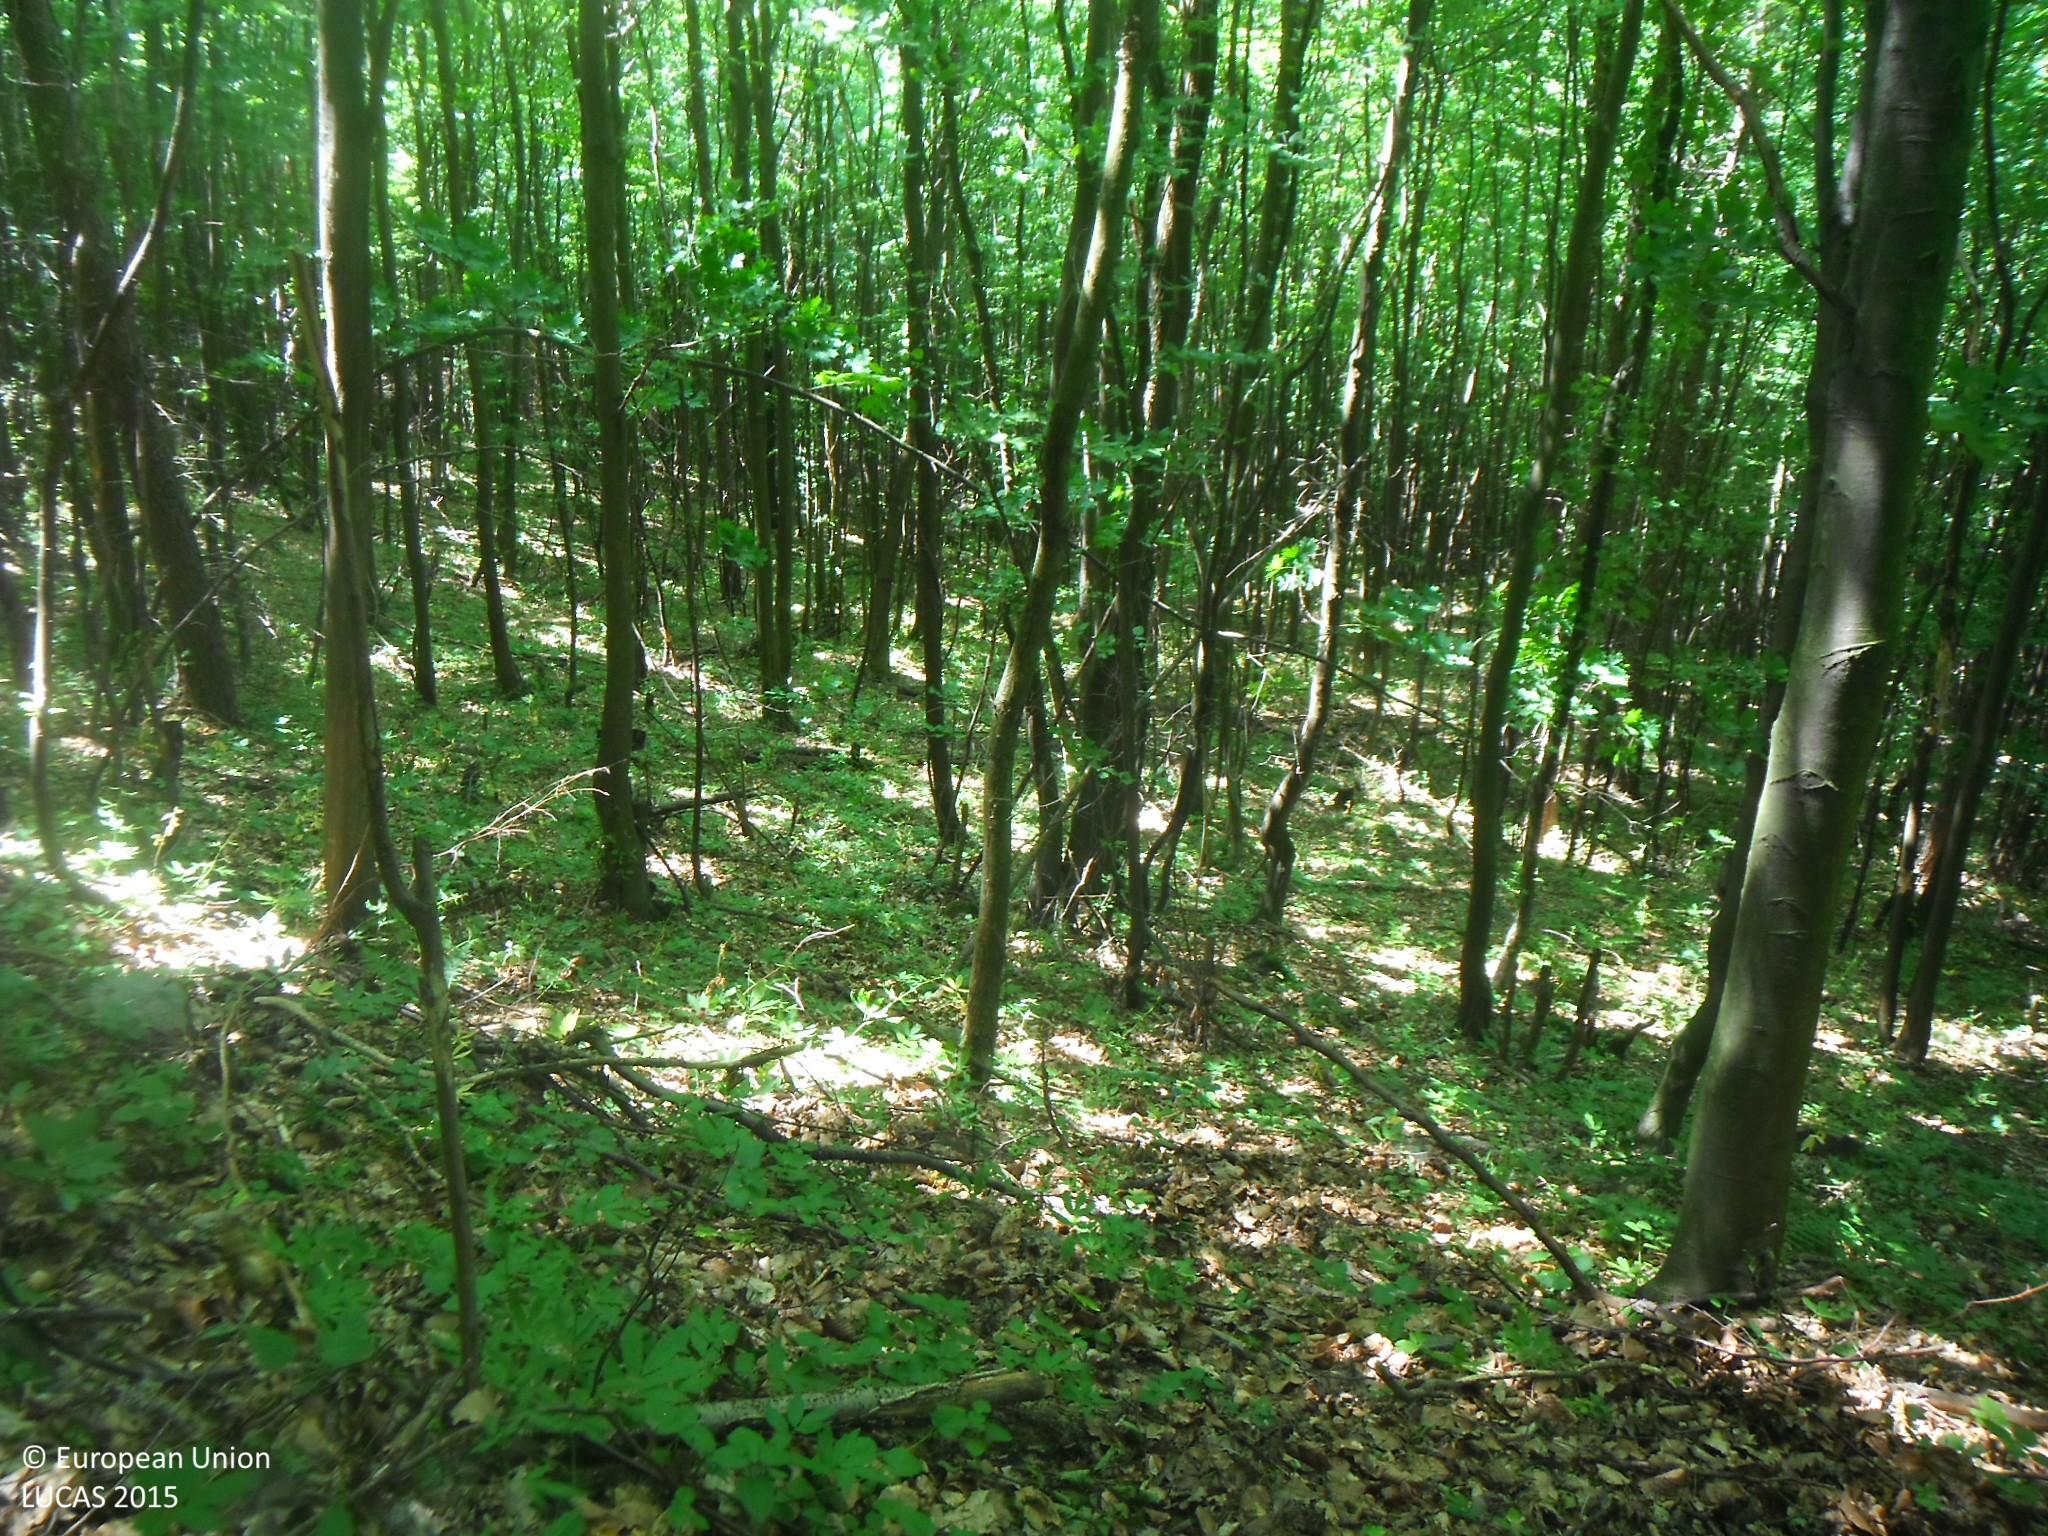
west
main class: Woodland
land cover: Broadleaved woodland
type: beech forest
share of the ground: > 75 %
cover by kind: broadleaved forest trees 100 %
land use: Forestry
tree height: > 5 m
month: June
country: SK
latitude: 48.9634
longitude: 21.5082
